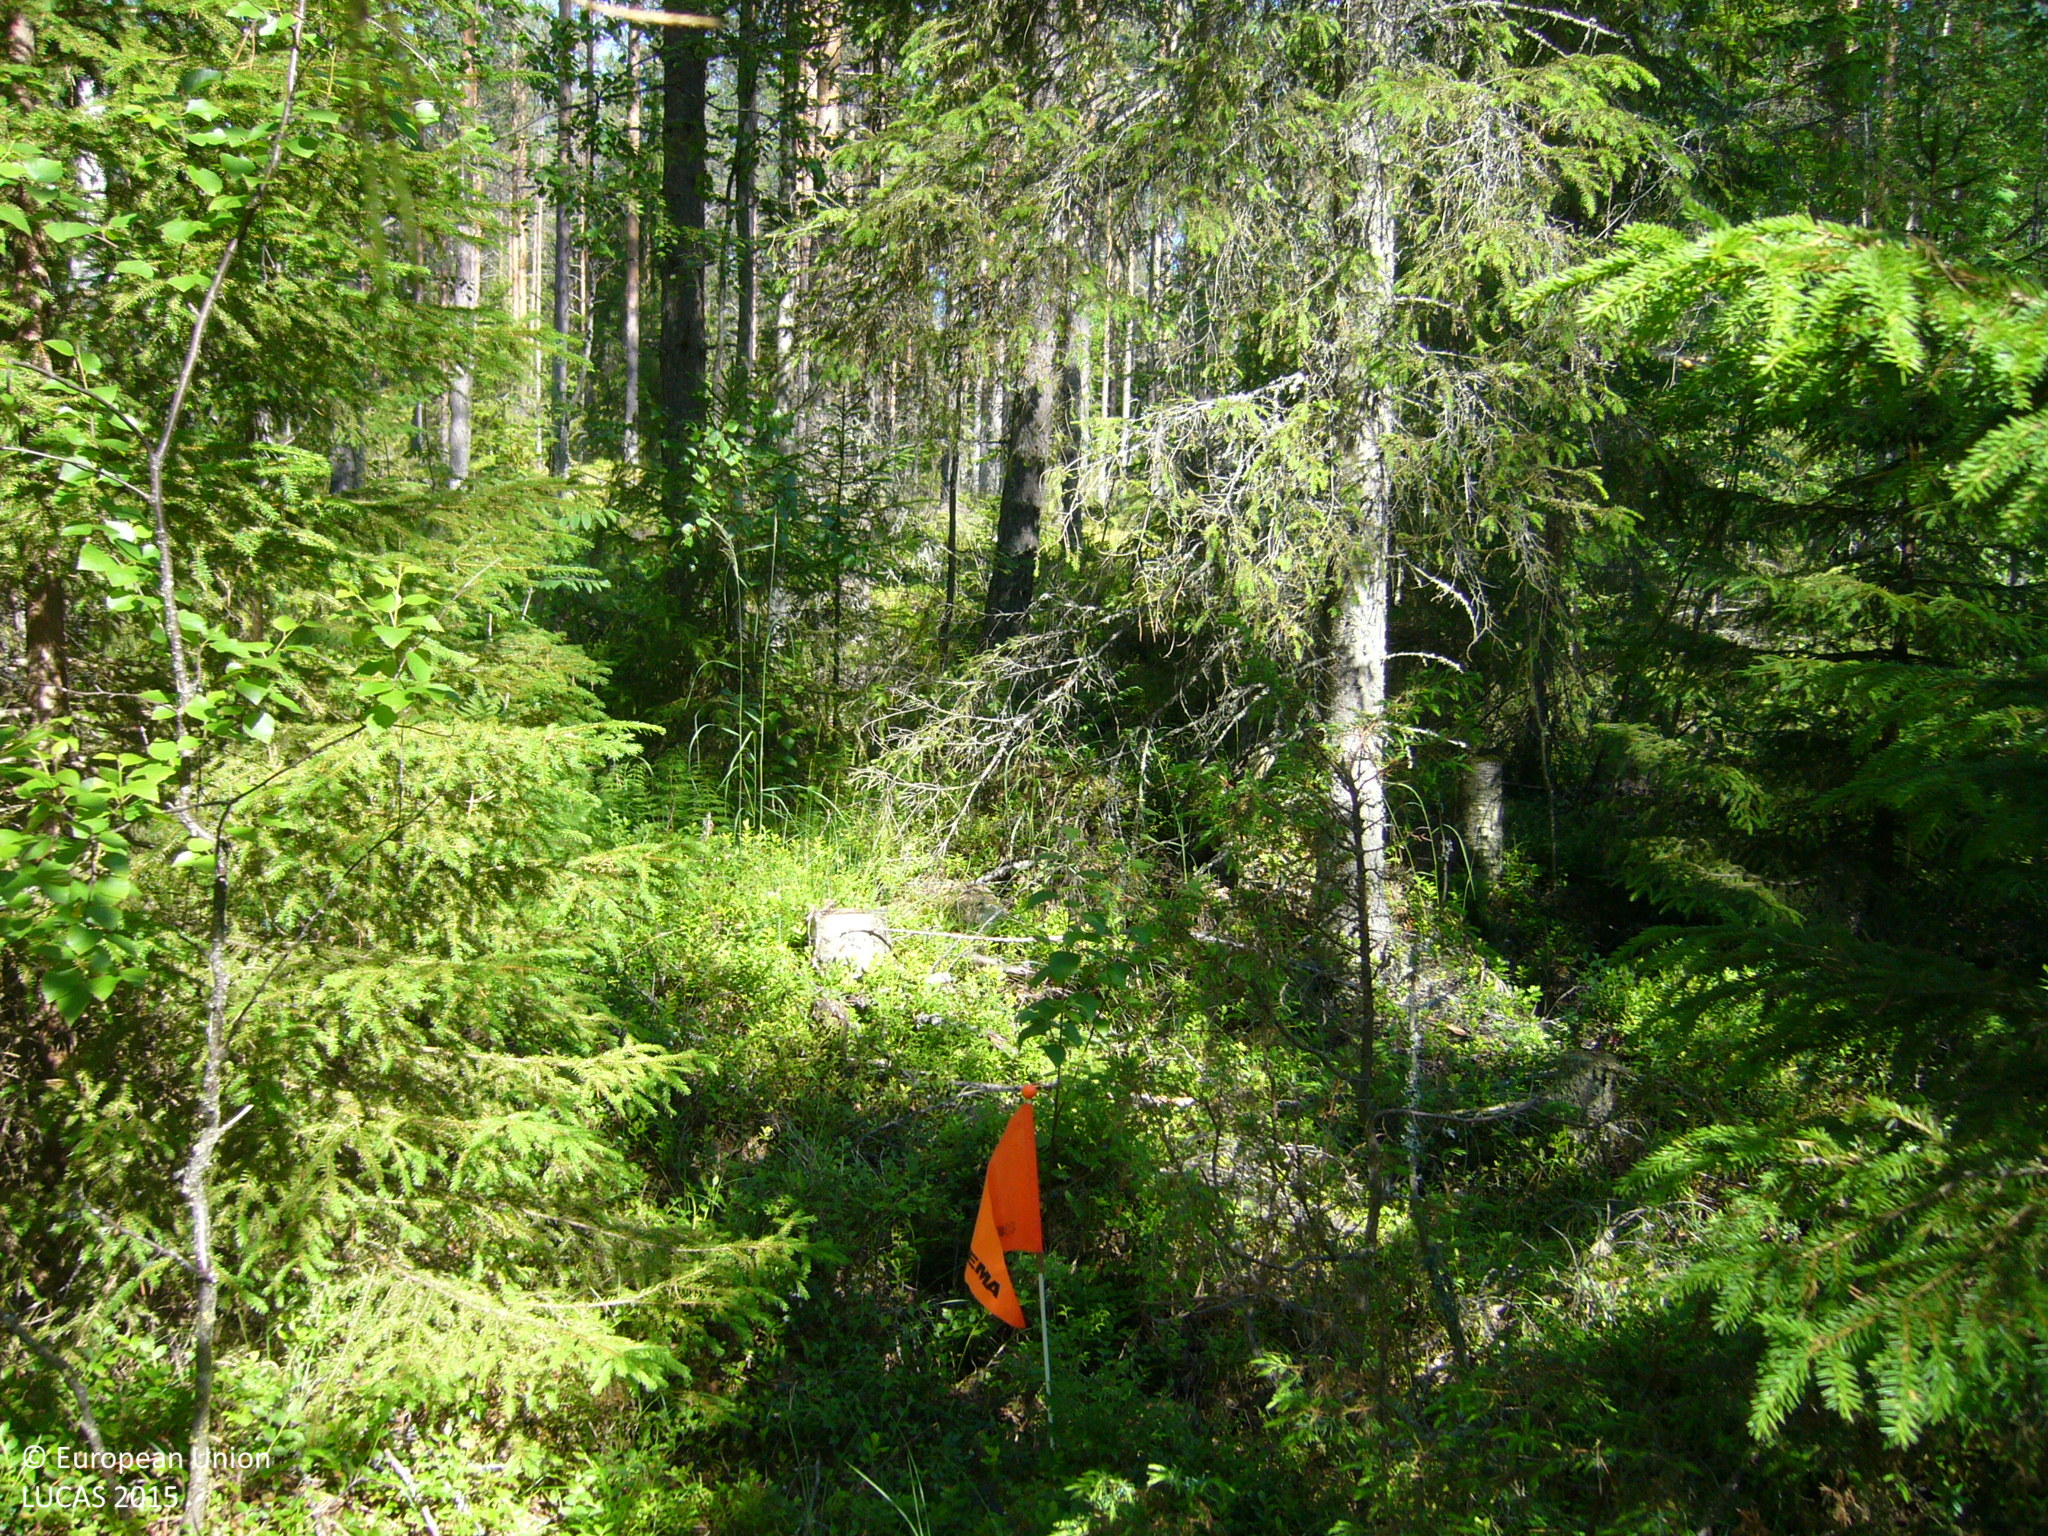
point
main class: Woodland
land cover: Pine dominated coniferous woodland
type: boreal forest
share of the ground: 50 - 75 %
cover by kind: coniferous forest trees 60 %, shrubs 30 %, broadleaved forest trees 10 %
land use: Forestry
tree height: > 5 m
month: July
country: FI
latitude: 63.3545
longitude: 25.8404
